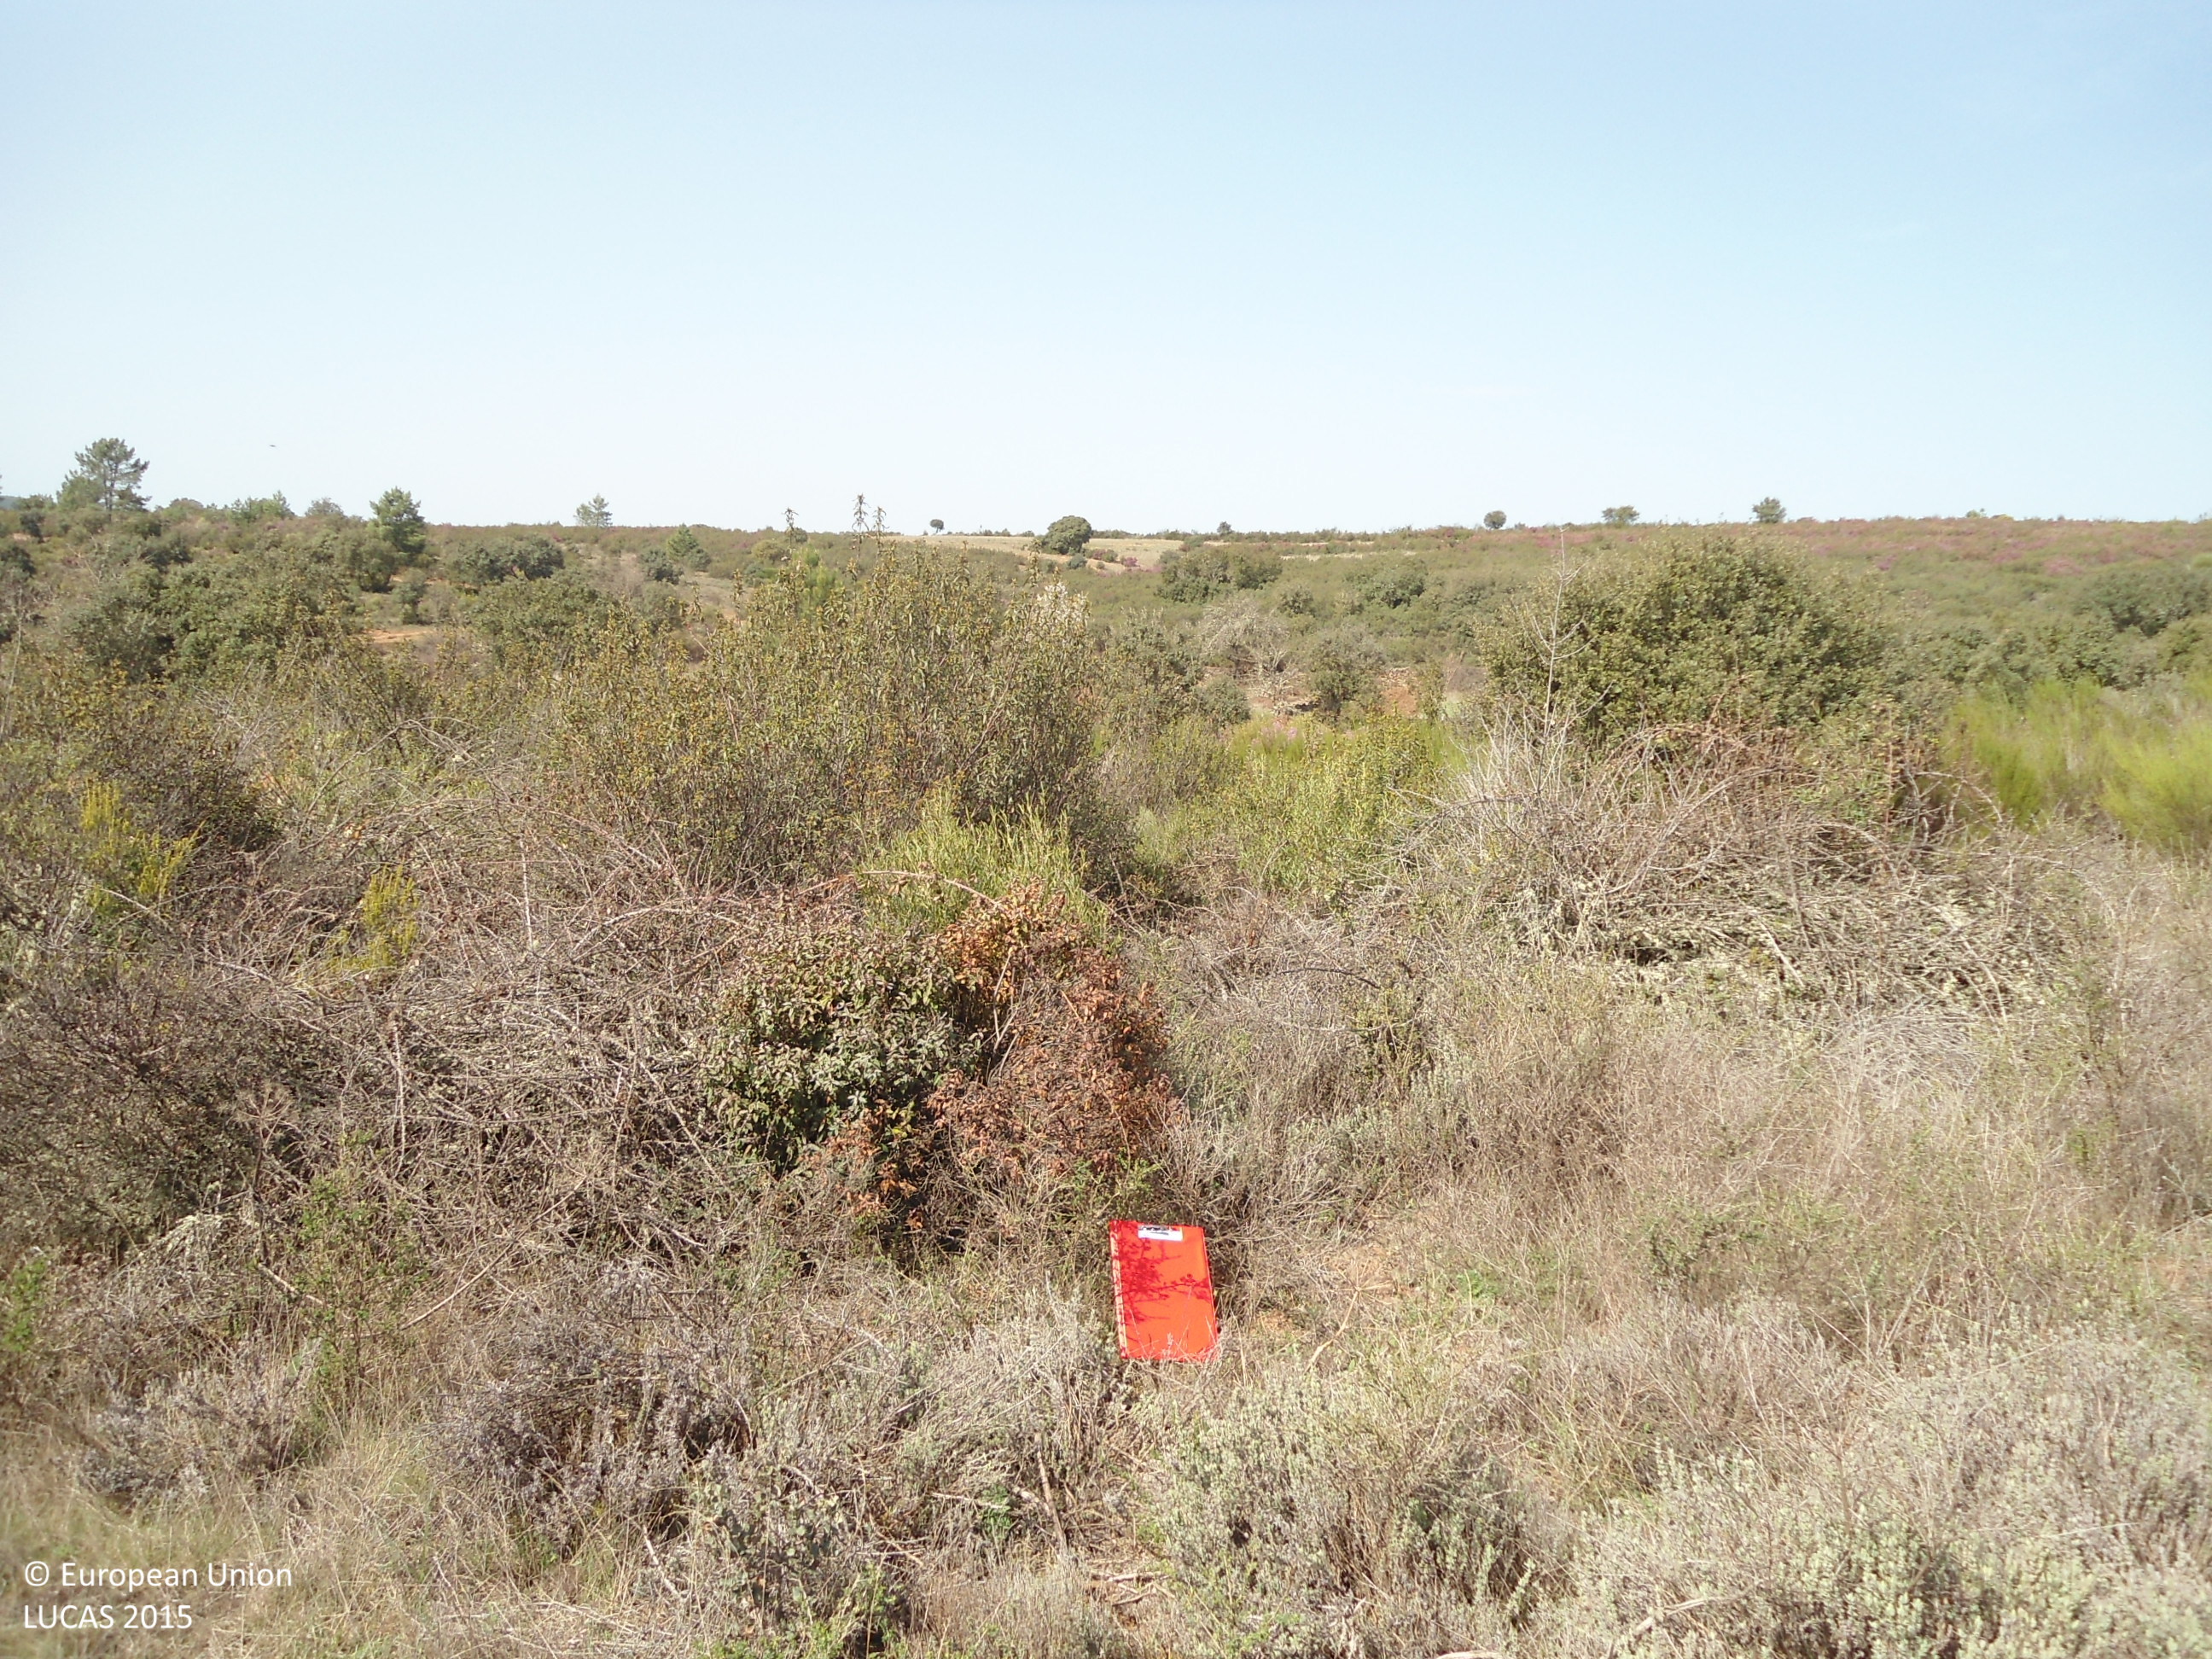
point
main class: Shrubland
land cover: Shrubland without tree cover
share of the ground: > 75 %
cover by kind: shrubs 90 %, herbaceous plants 10 %
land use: Semi-natural and natural areas not in use
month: April
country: ES
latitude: 41.7013
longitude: -6.4595
